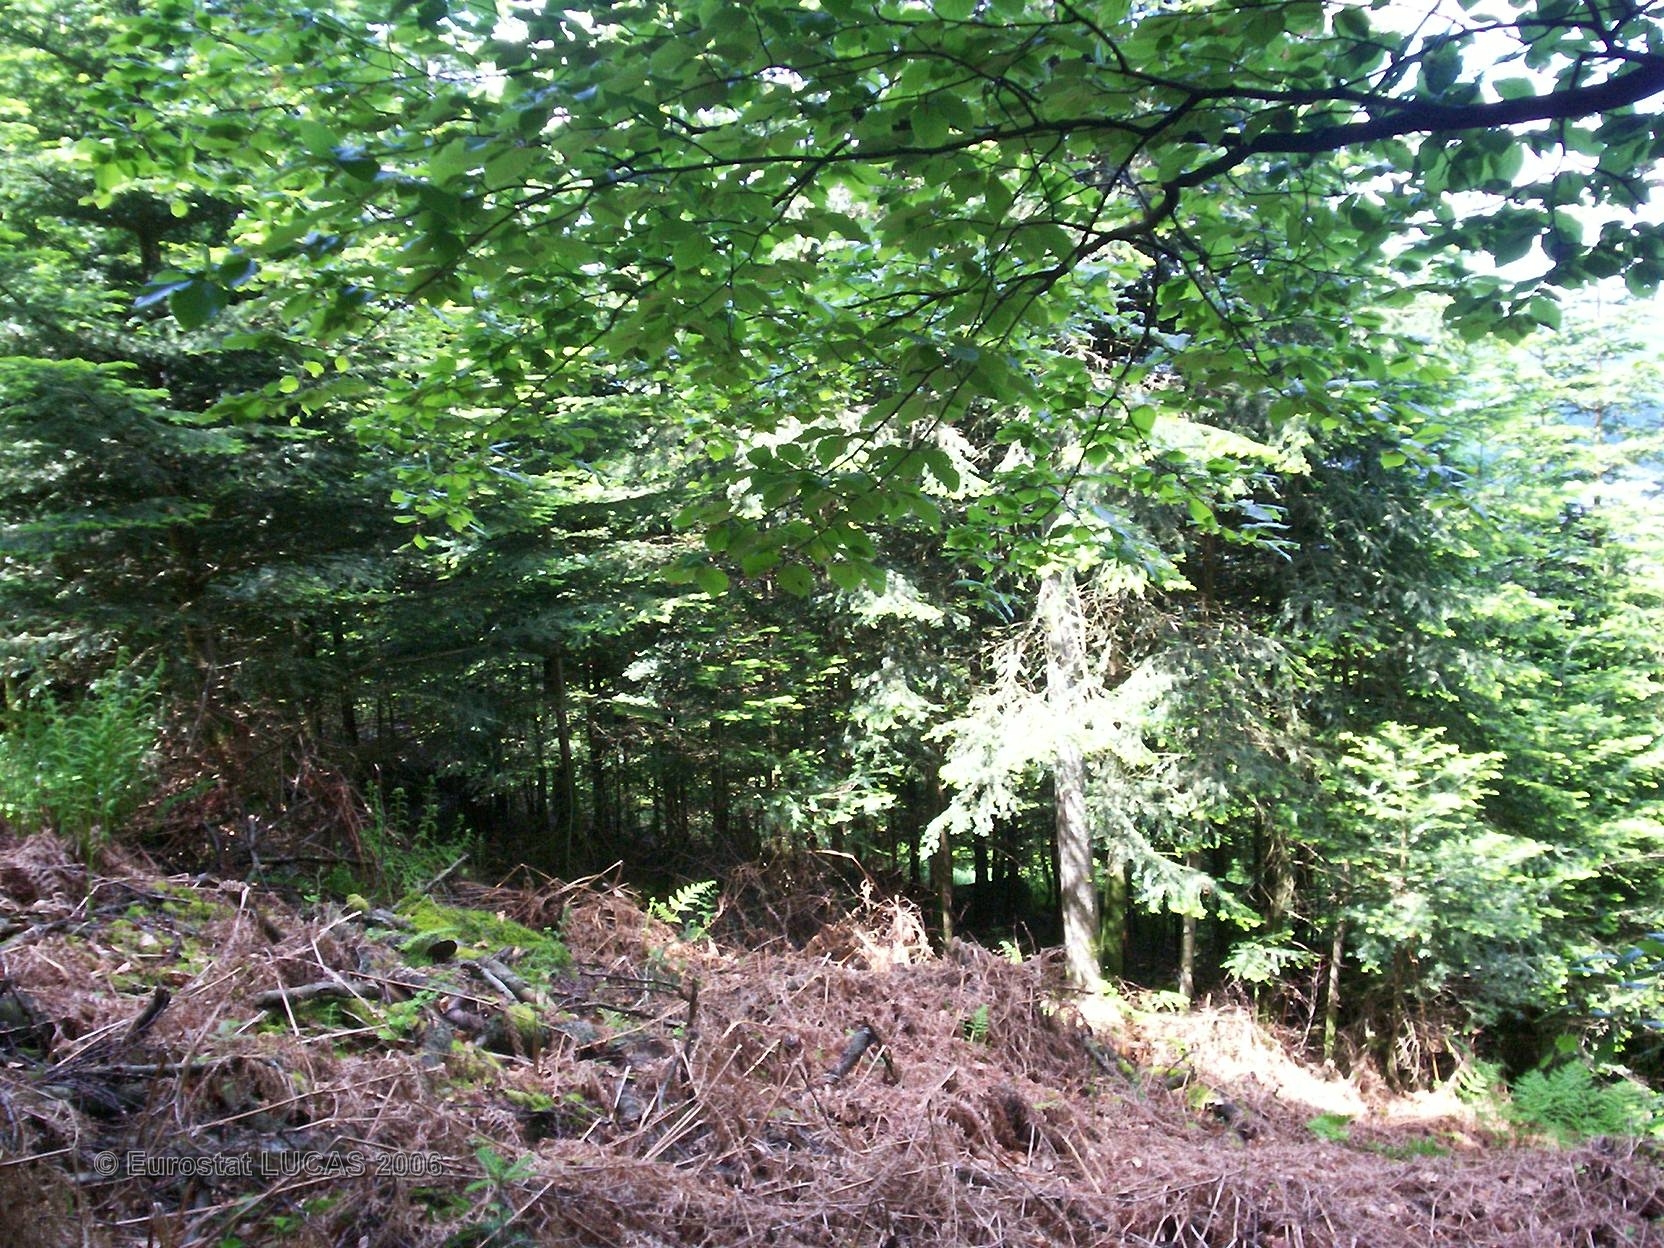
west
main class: Woodland
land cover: Mixed forest
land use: Forestry
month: May
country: FR
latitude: 48.0453
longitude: 6.6072
